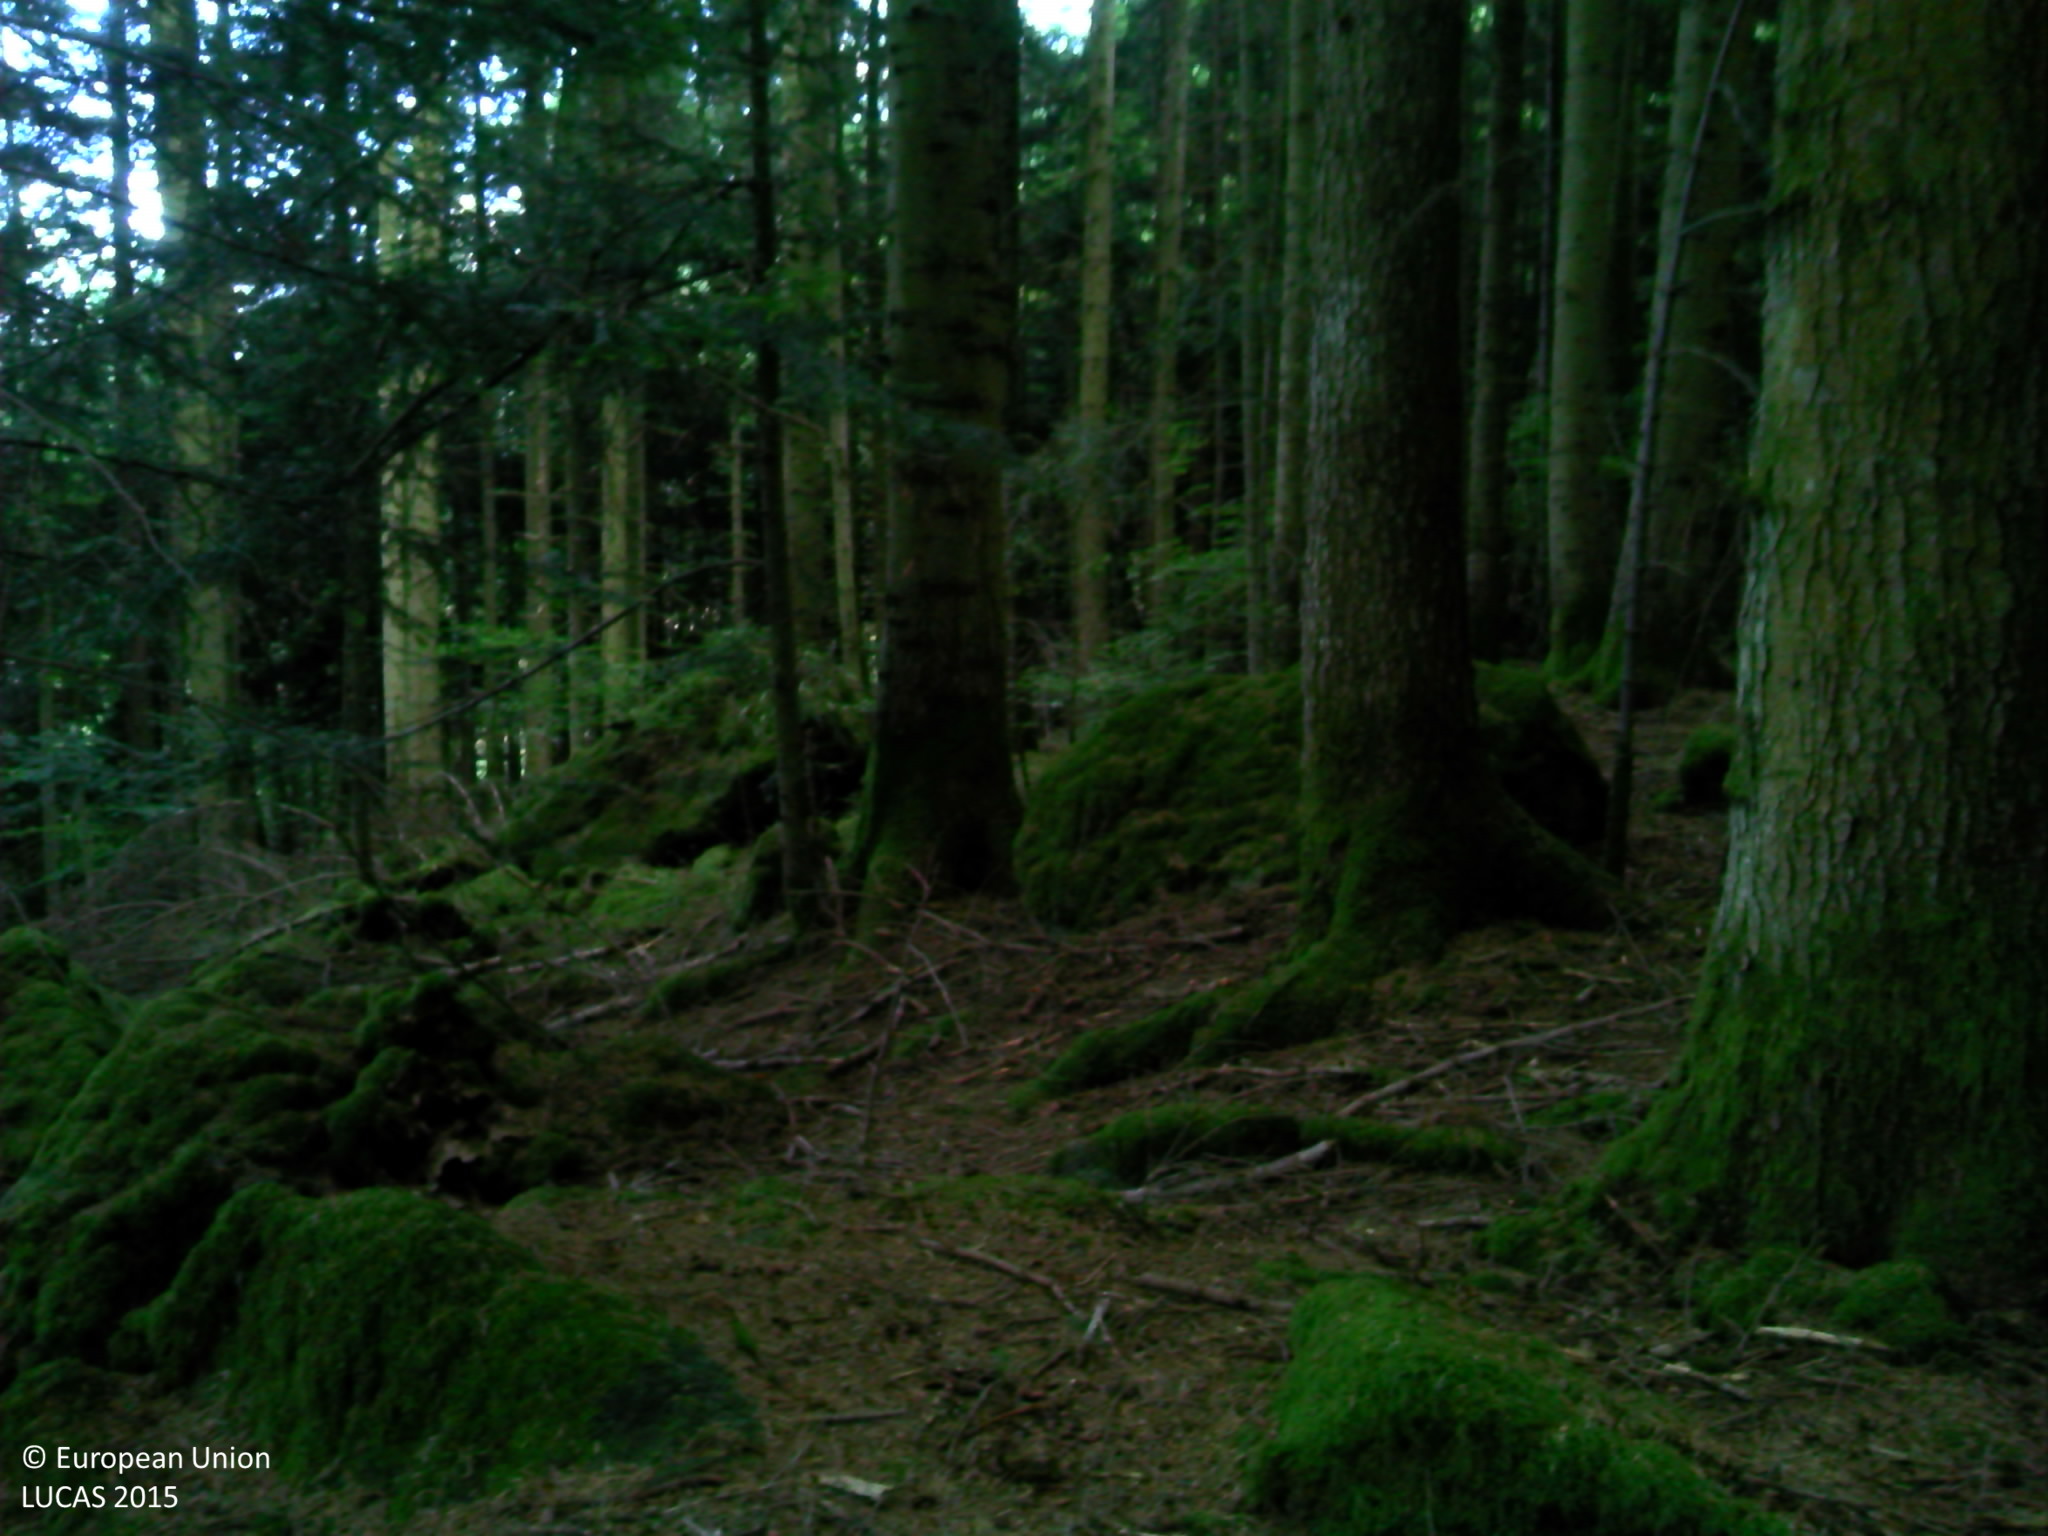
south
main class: Woodland
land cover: Spruce dominated coniferous woodland
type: alpine coniferous forest
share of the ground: > 75 %
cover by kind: coniferous forest trees 100 %
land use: Forestry
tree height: > 5 m
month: August
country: FR
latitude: 46.2273
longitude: 4.4916
